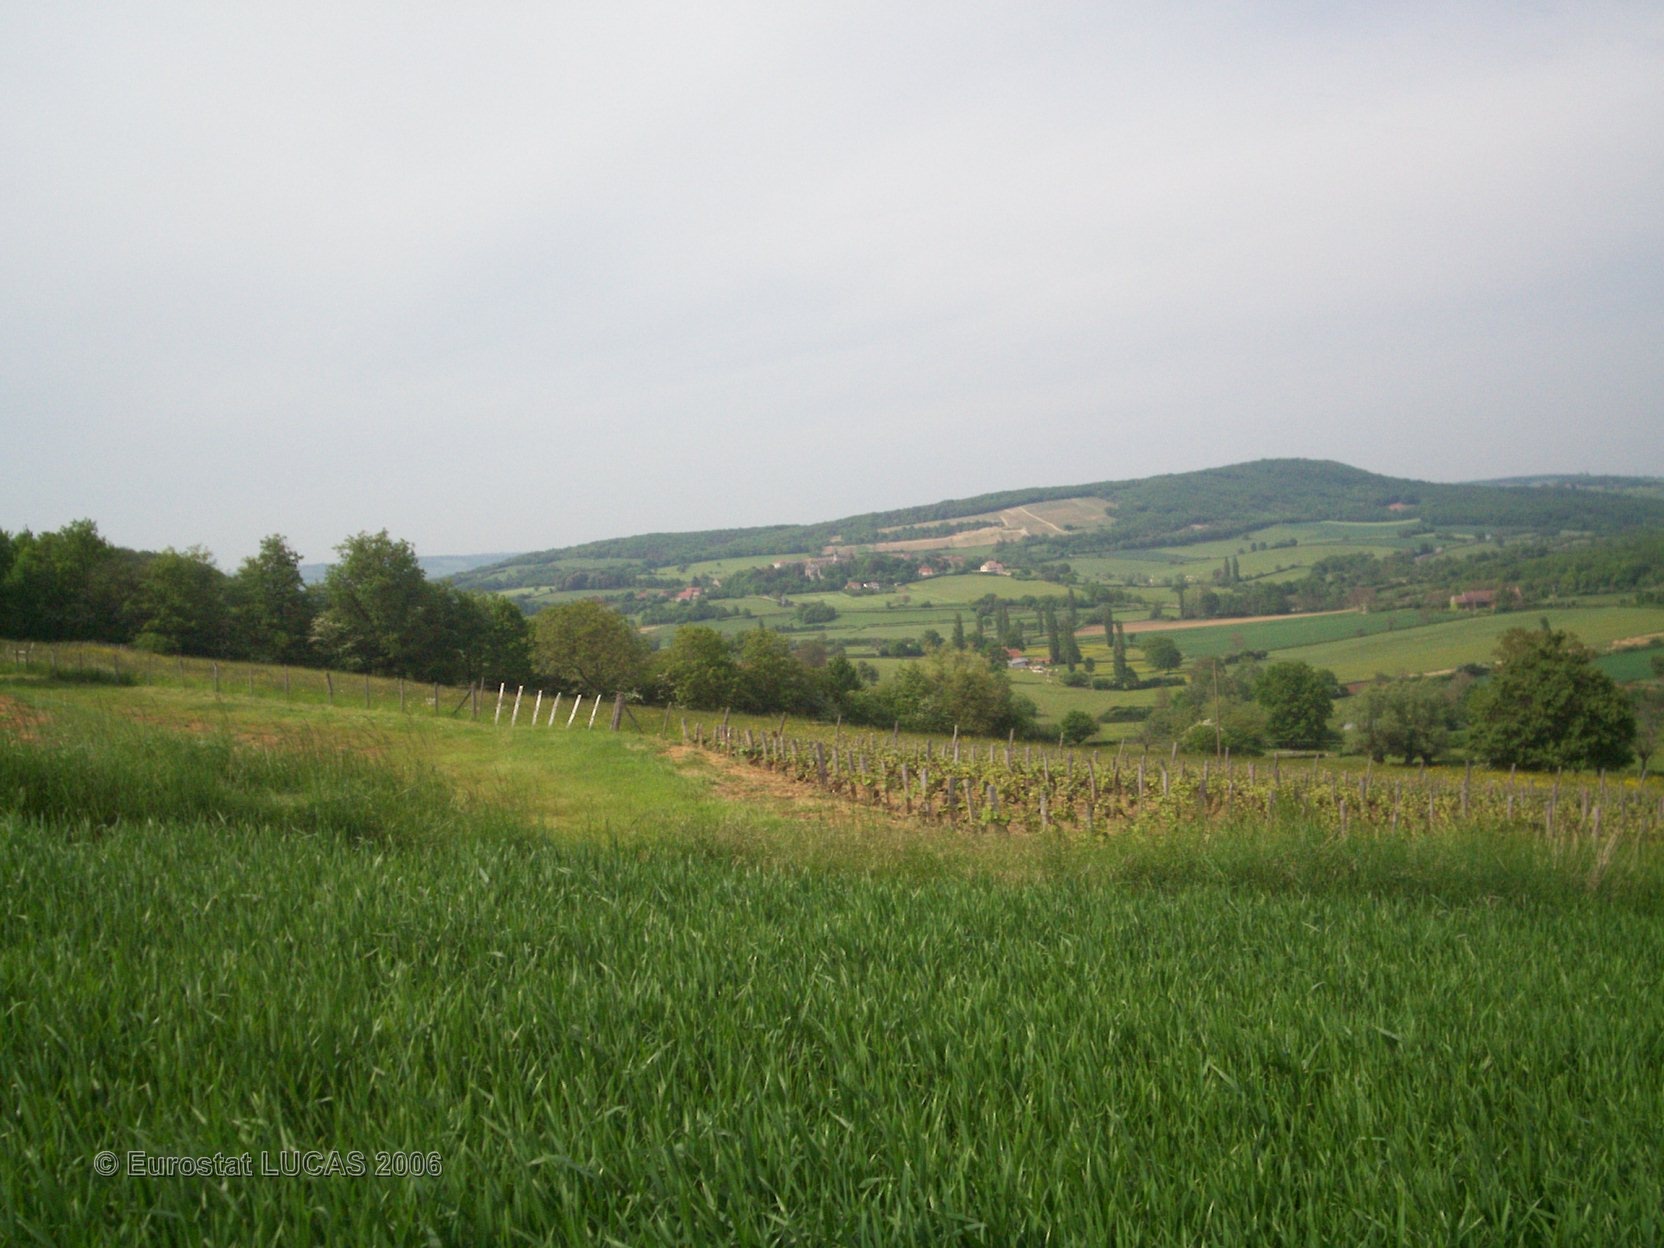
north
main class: Cropland
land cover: Common wheat
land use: Agriculture (excluding fallow land and kitchen gardens)
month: May
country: FR
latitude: 46.6675
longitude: 4.6292
